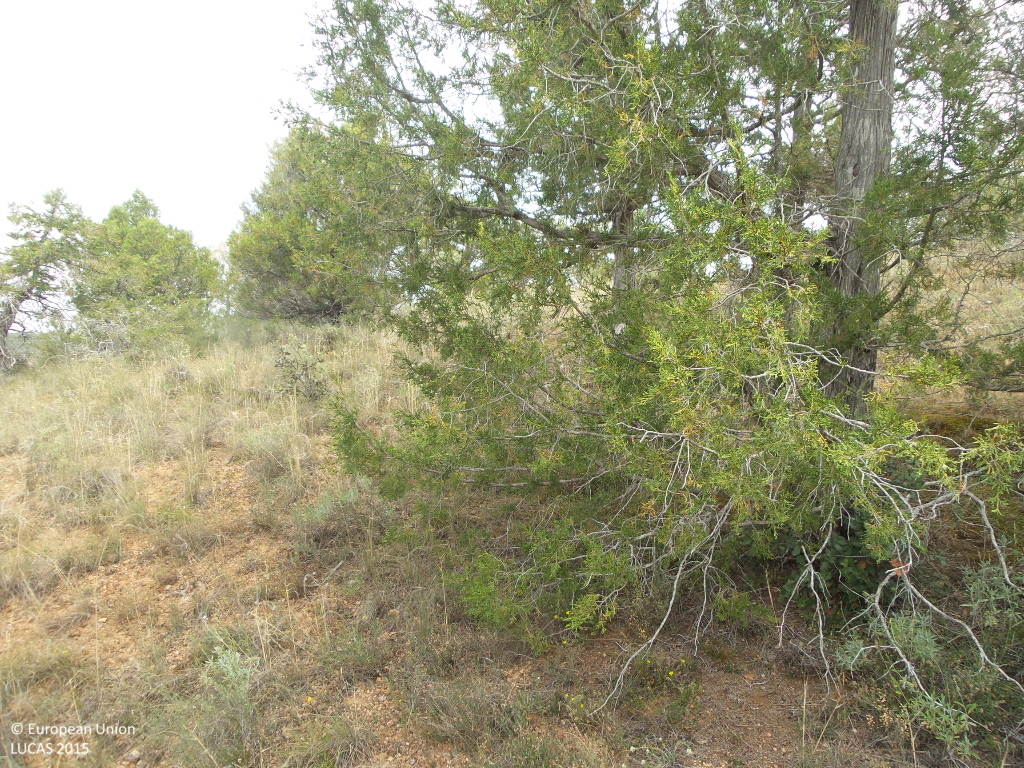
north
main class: Woodland
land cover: Other mixed woodland
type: coniferous forest of the mediterranean region
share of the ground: 50 - 75 %
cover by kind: coniferous forest trees 40 %, broadleaved forest trees 15 %, shrubs 15 %, herbaceous plants 15 %, unconsolidated bare surface 10 %, lichens and mosses 5 %
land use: Semi-natural and natural areas not in use
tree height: < 5 m
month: June
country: ES
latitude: 41.5383
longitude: -2.9994
